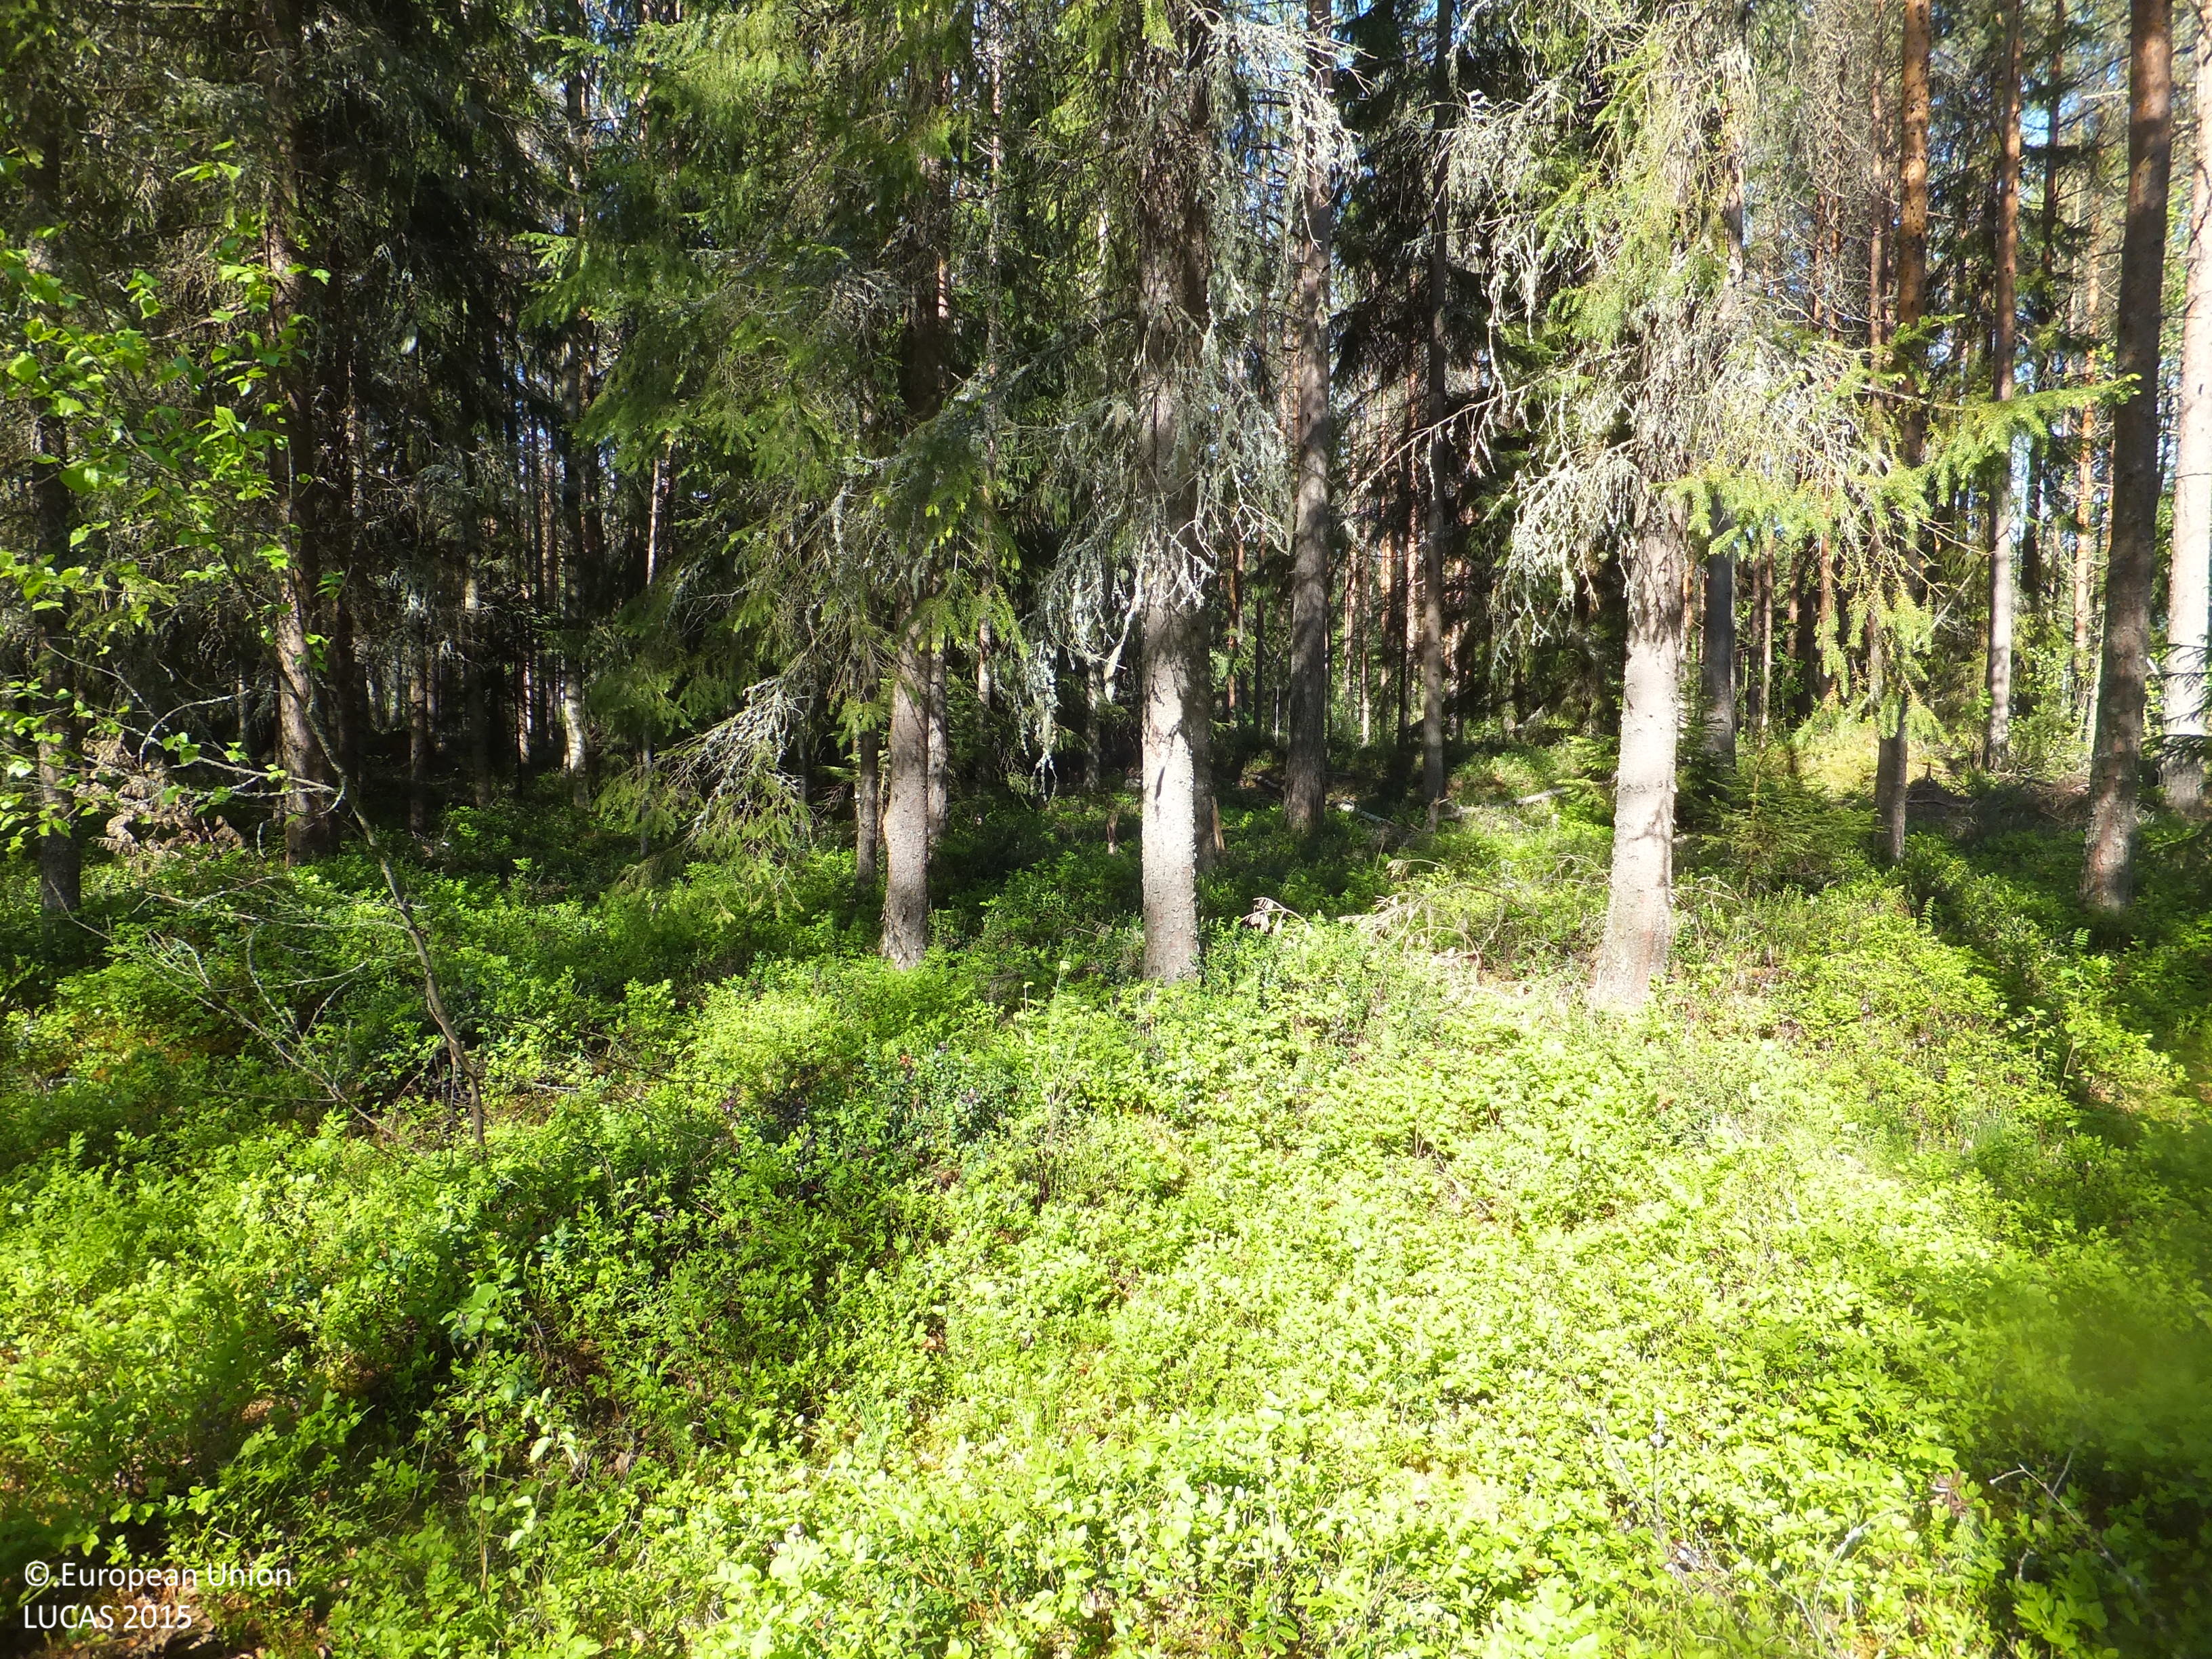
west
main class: Woodland
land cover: Other mixed woodland
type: boreal forest
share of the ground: > 75 %
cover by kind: coniferous forest trees 45 %, broadleaved forest trees 30 %, shrubs 20 %, lichens and mosses 5 %
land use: Forestry
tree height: > 5 m
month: June
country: FI
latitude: 63.6125
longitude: 22.8981
